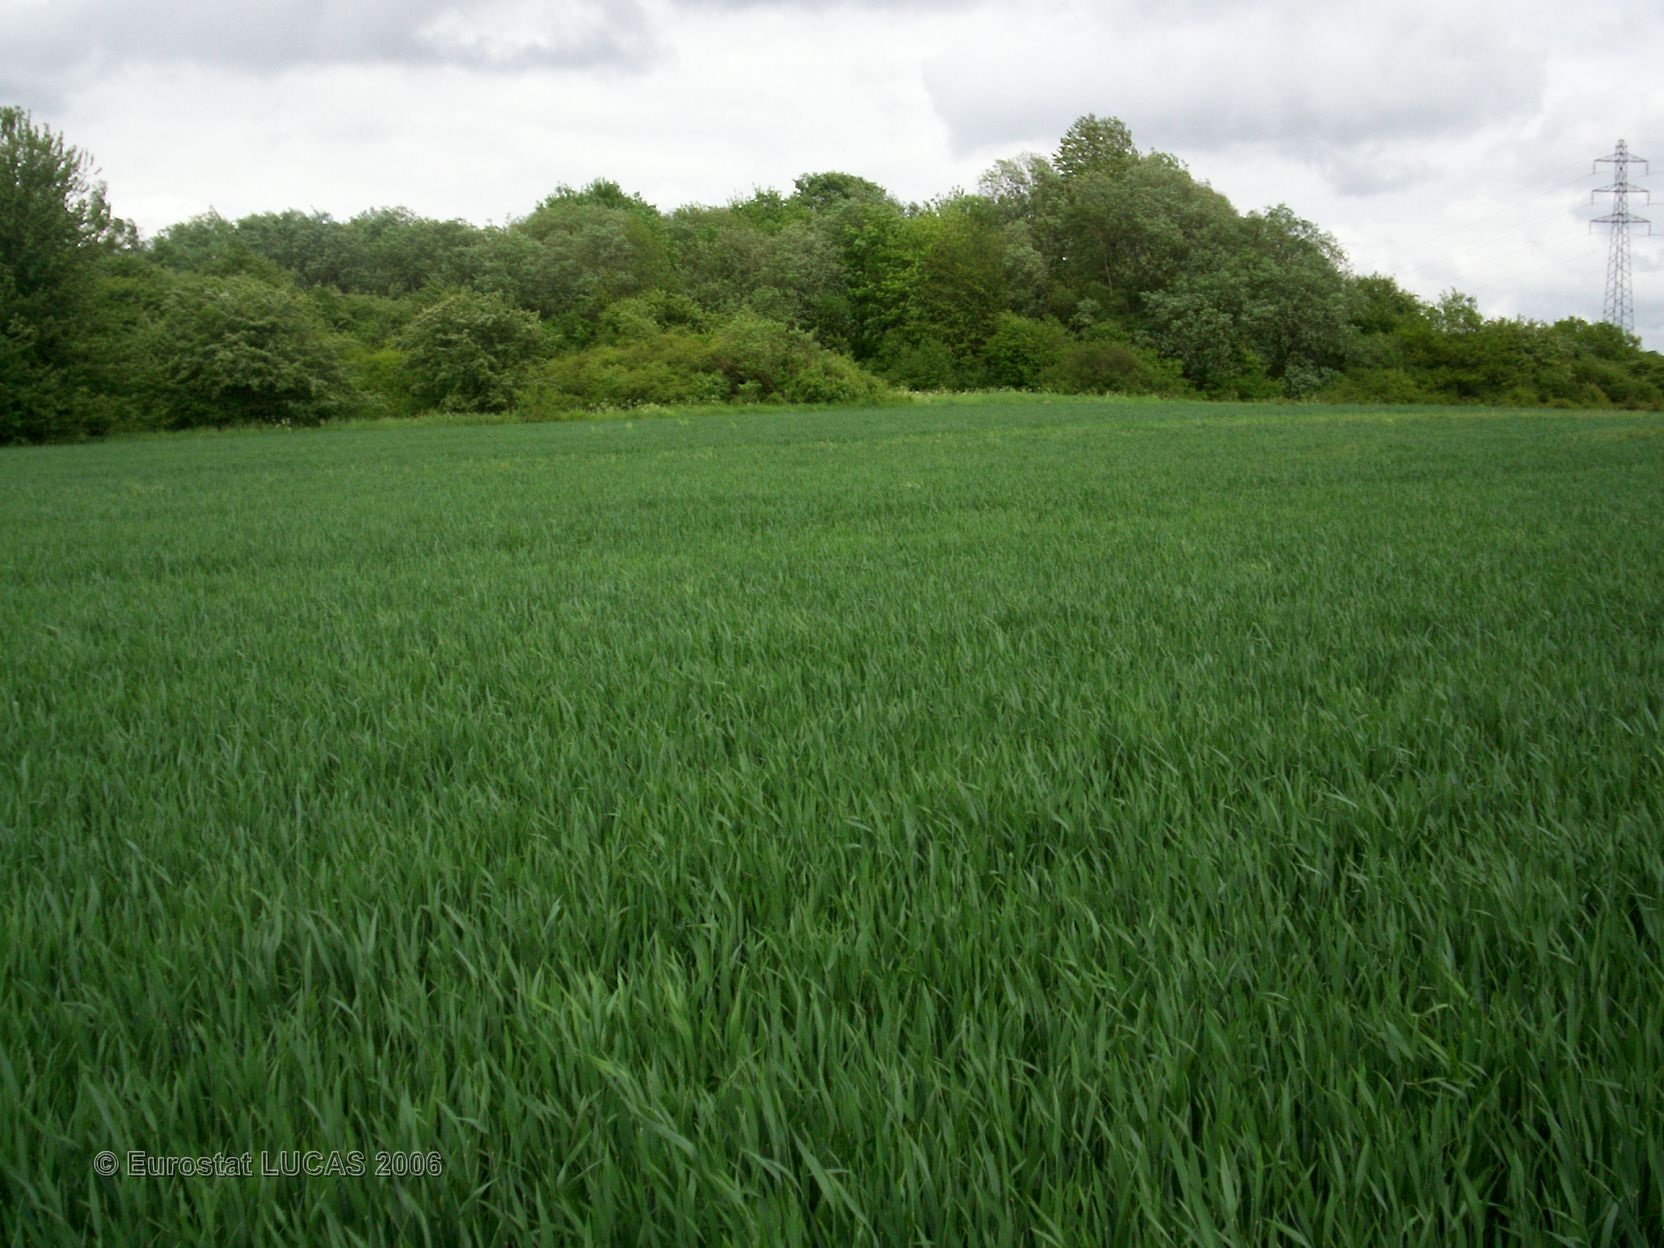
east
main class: Cropland
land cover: Common wheat
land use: Agriculture (excluding fallow land and kitchen gardens)
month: May
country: FR
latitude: 49.4783
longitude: 5.8447
